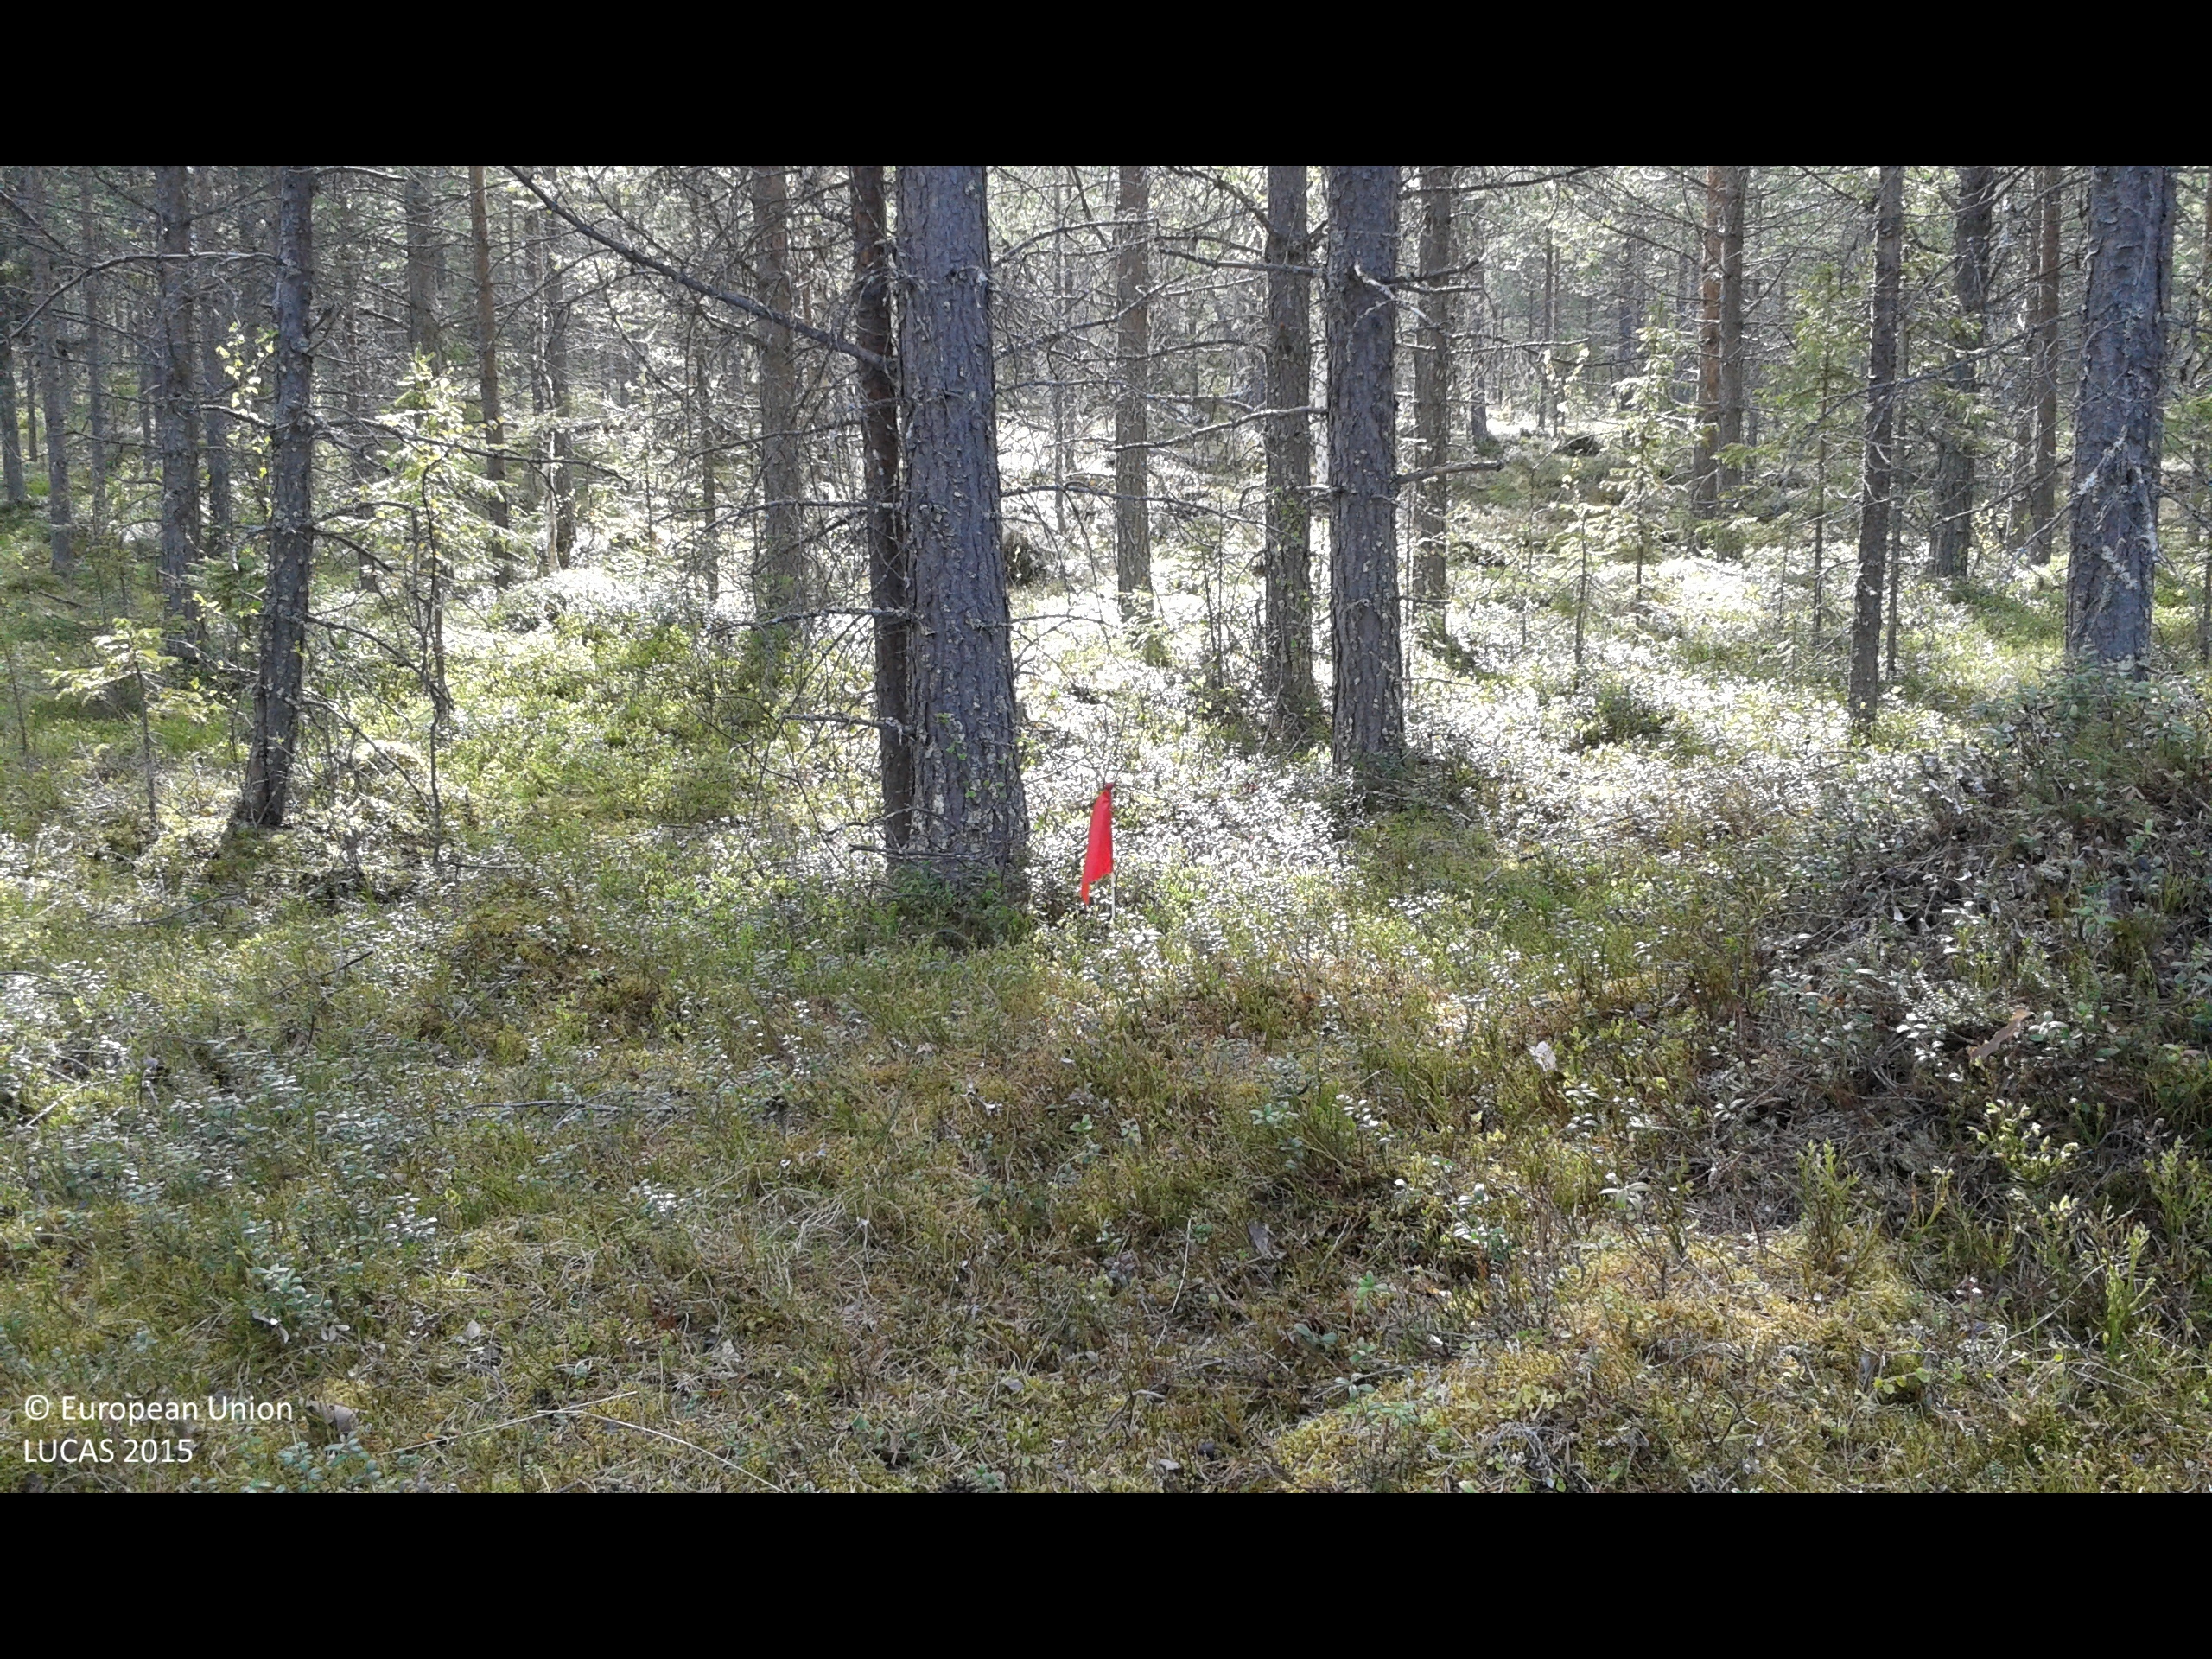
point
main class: Woodland
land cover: Pine dominated coniferous woodland
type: boreal forest
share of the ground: 25 - 50 %
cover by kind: herbaceous plants 55 %, coniferous forest trees 40 %, lichens and mosses 5 %
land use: Forestry
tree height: > 5 m
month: June
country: SE
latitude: 66.9508
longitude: 21.1468
